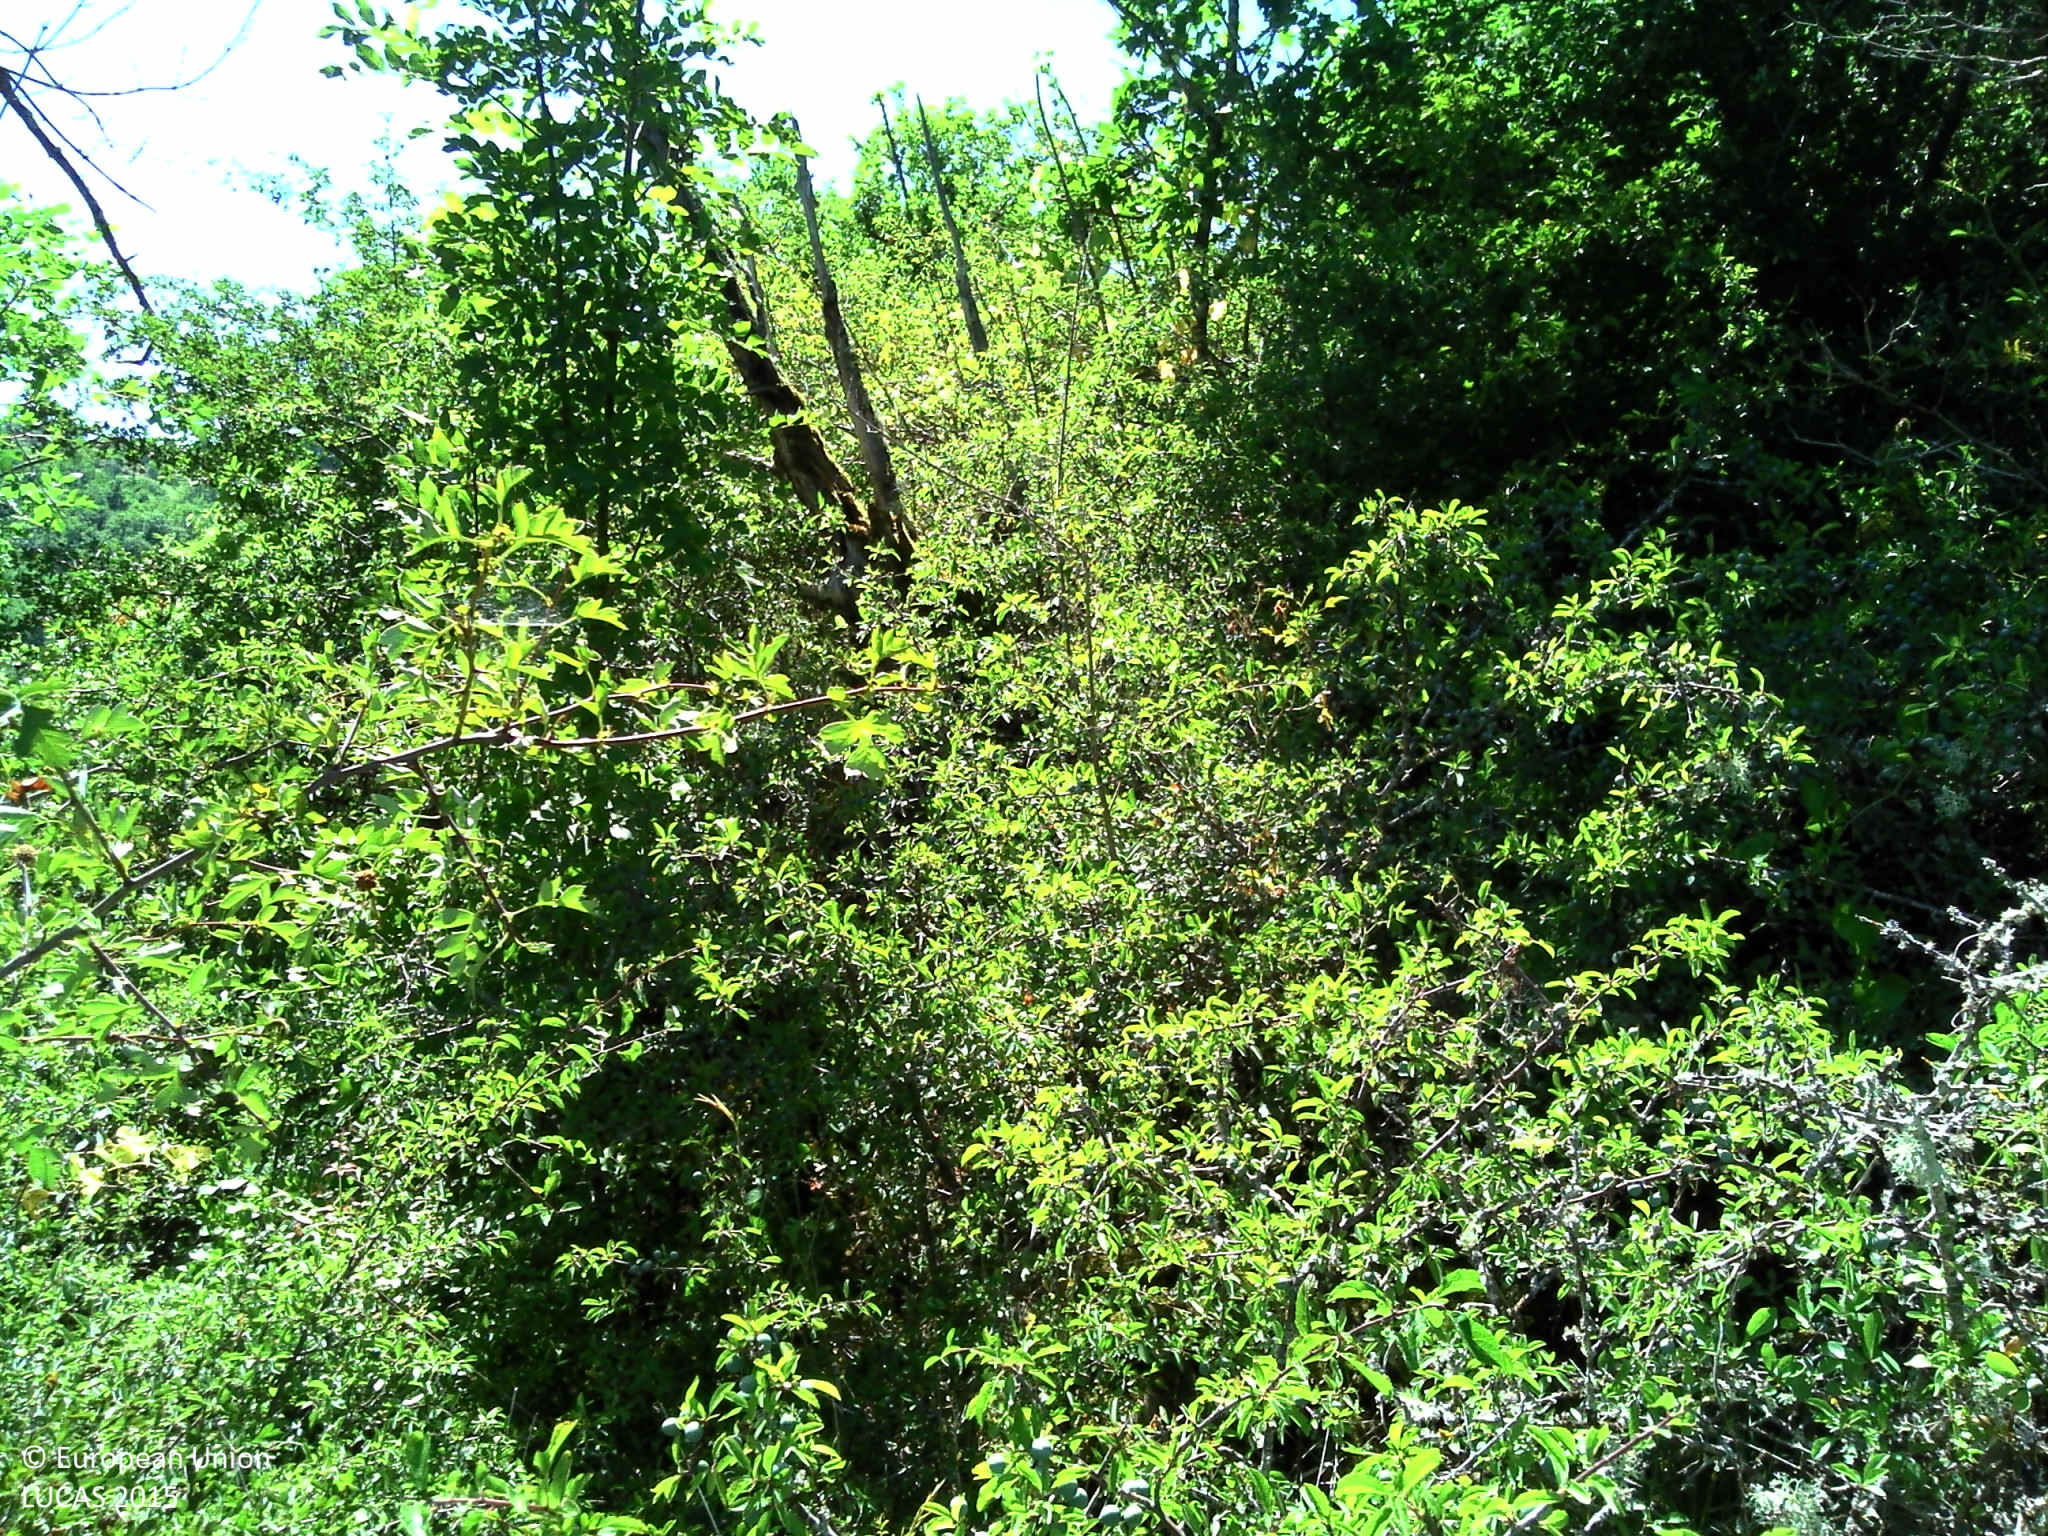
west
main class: Shrubland
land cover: Shrubland with sparse tree cover
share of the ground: > 75 %
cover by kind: shrubs 95 %, broadleaved forest trees 5 %
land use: Agriculture (excluding fallow land and kitchen gardens)
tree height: > 5 m
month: June
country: FR
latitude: 44.4734
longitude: 2.4471
